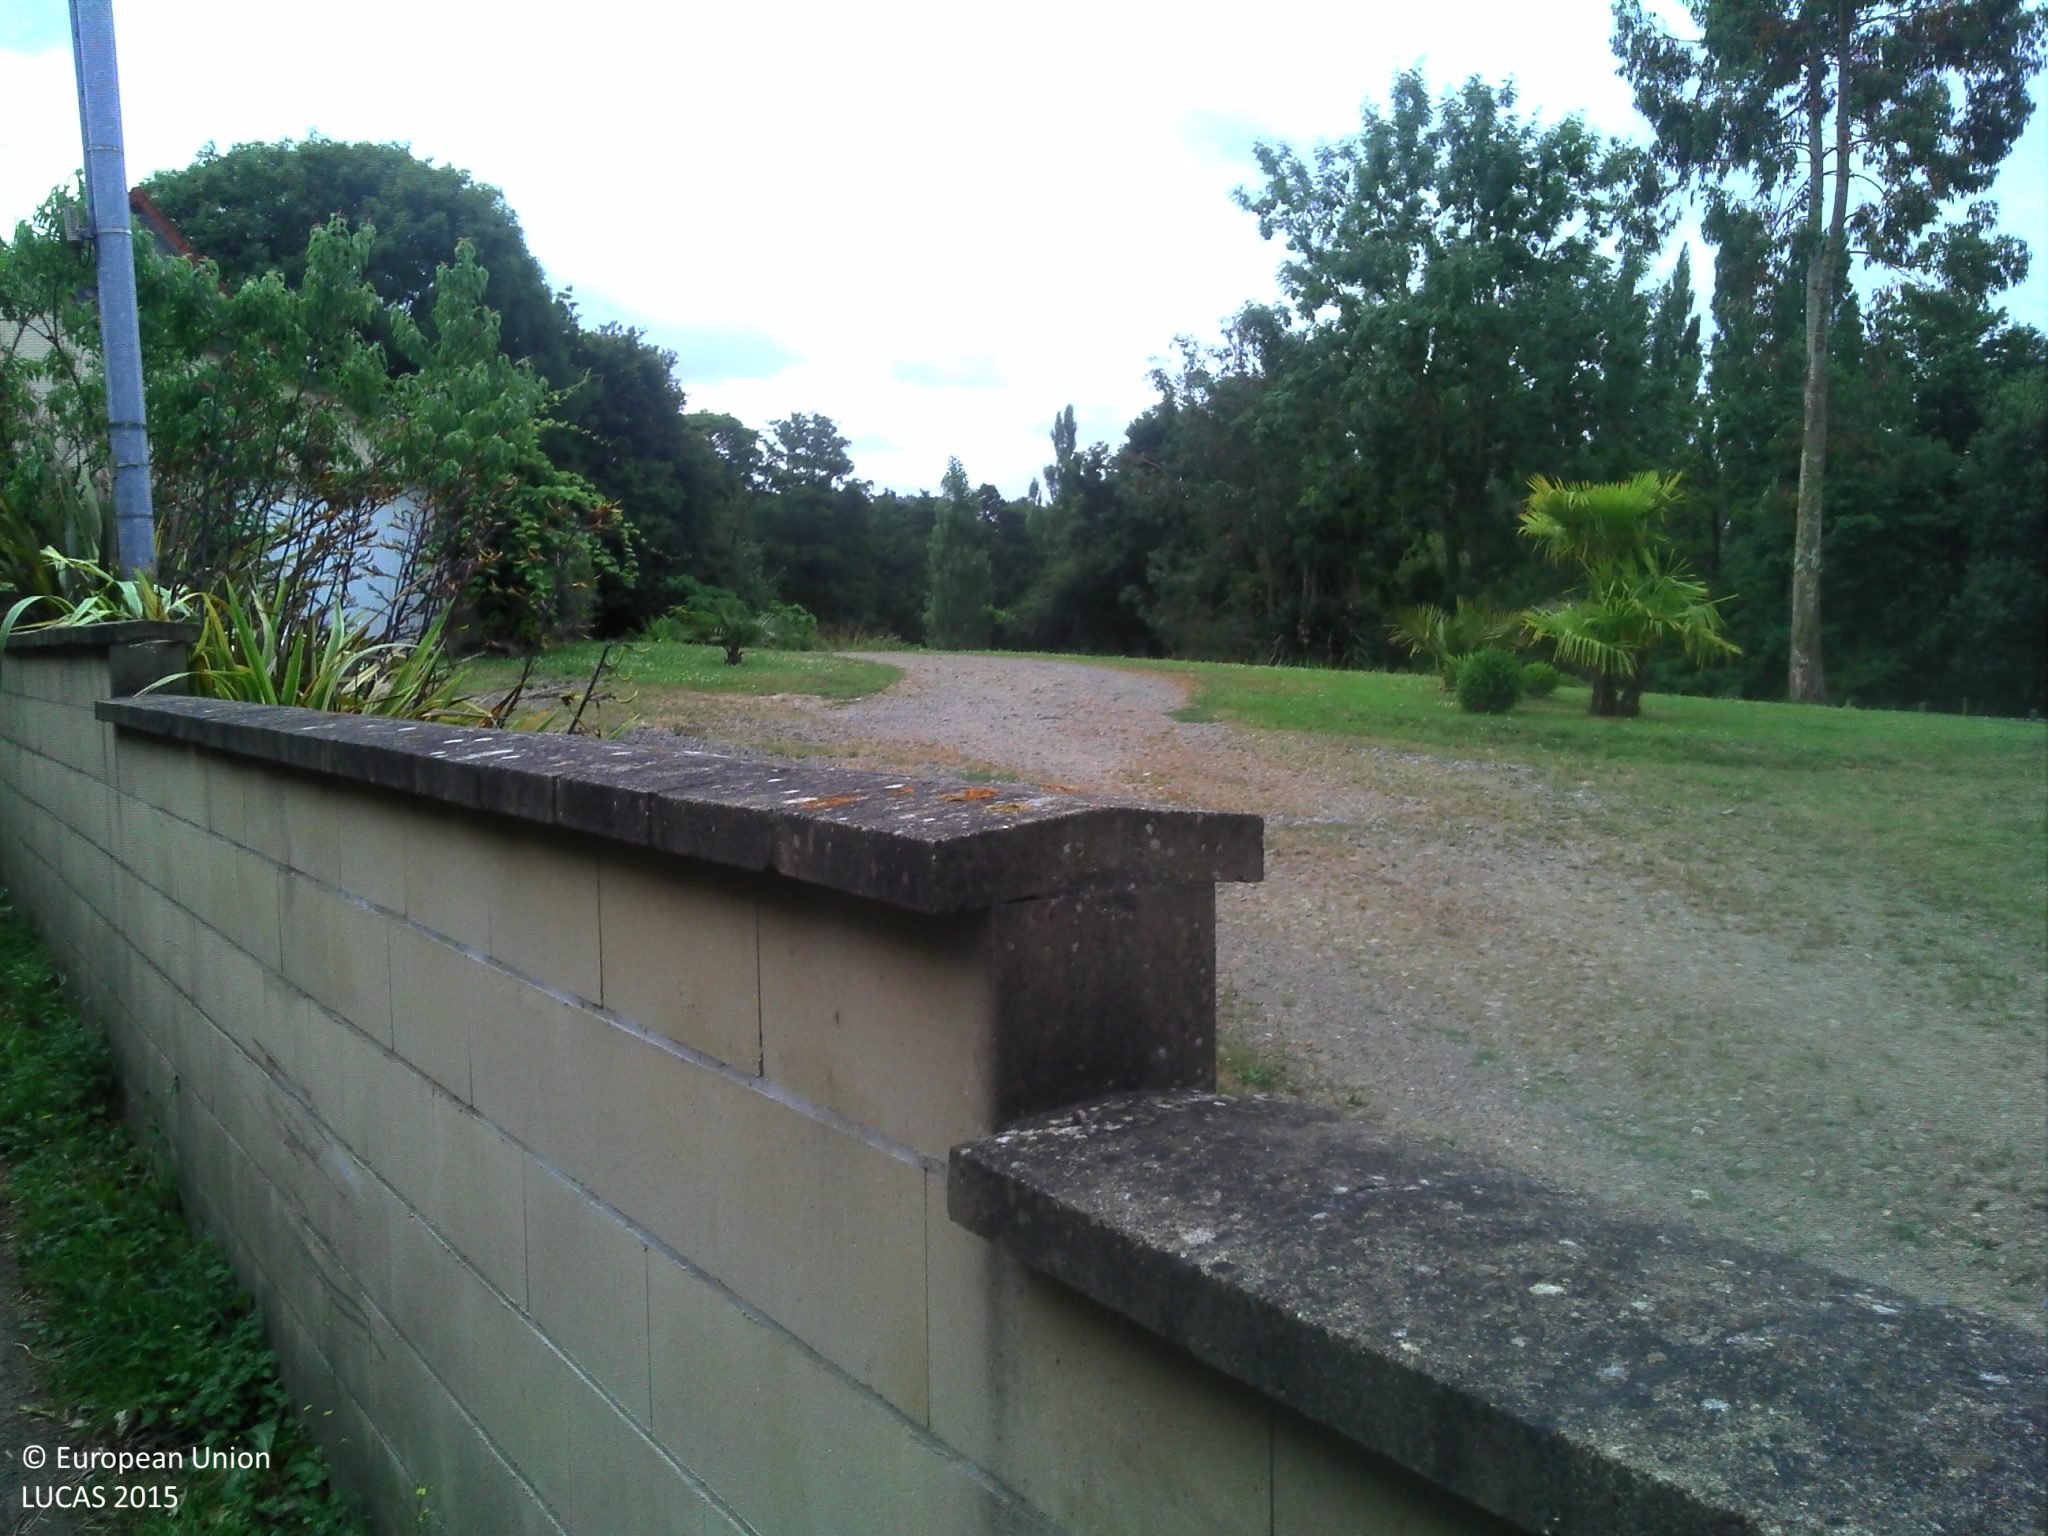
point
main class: Grassland
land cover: Grassland with sparse tree/shrub cover
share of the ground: > 75 %
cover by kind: herbaceous plants 95 %, broadleaved forest trees 5 %
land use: Residential
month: July
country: FR
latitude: 48.8513
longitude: -1.5372
